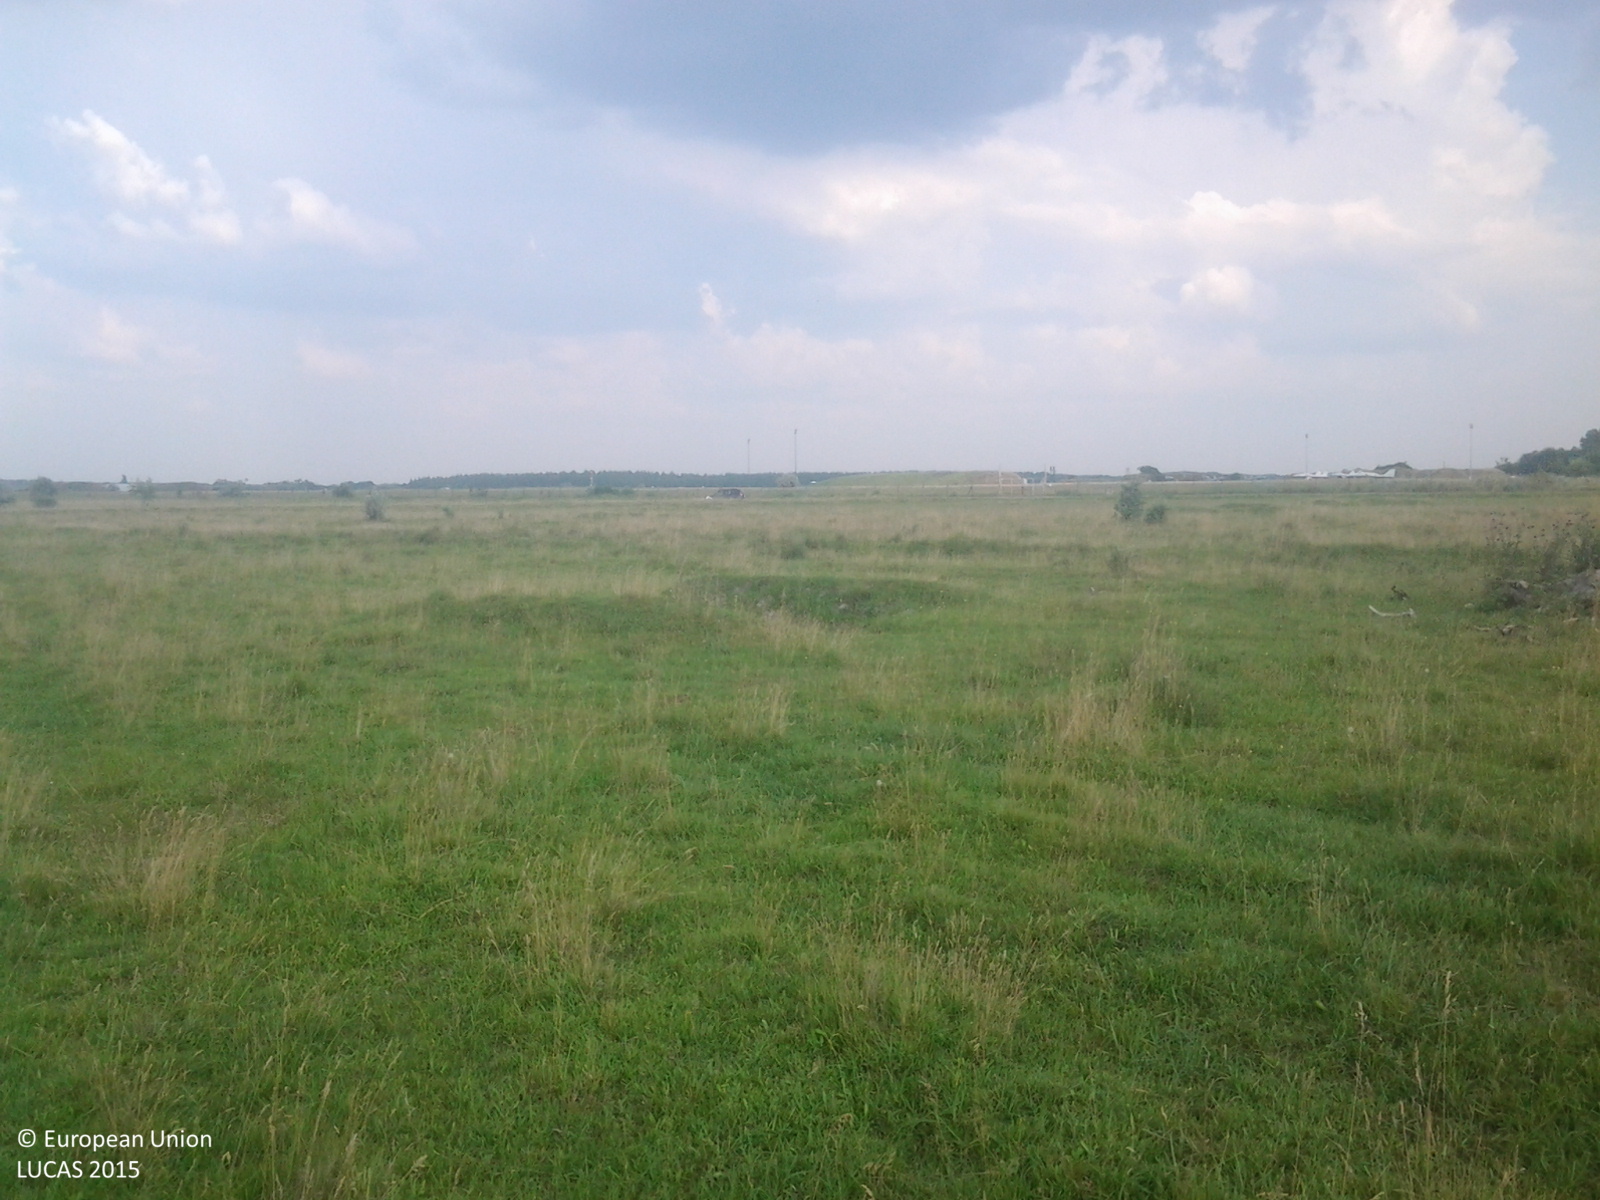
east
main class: Grassland
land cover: Grassland without tree/shrub cover
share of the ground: > 75 %
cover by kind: herbaceous plants 100 %
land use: Agriculture (excluding fallow land and kitchen gardens)
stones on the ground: < 10 %
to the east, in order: Grassland without tree/shrub cover; Ditches and canals; Grassland without tree/shrub cover; Tracks; Grassland without tree/shrub cover; Tracks; Grass margins; Fences; Grassland without tree/shrub cover; Paved roads, cycling and walking lanes; Grassland without tree/shrub cover
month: June
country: HU
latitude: 46.9225
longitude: 19.7258
